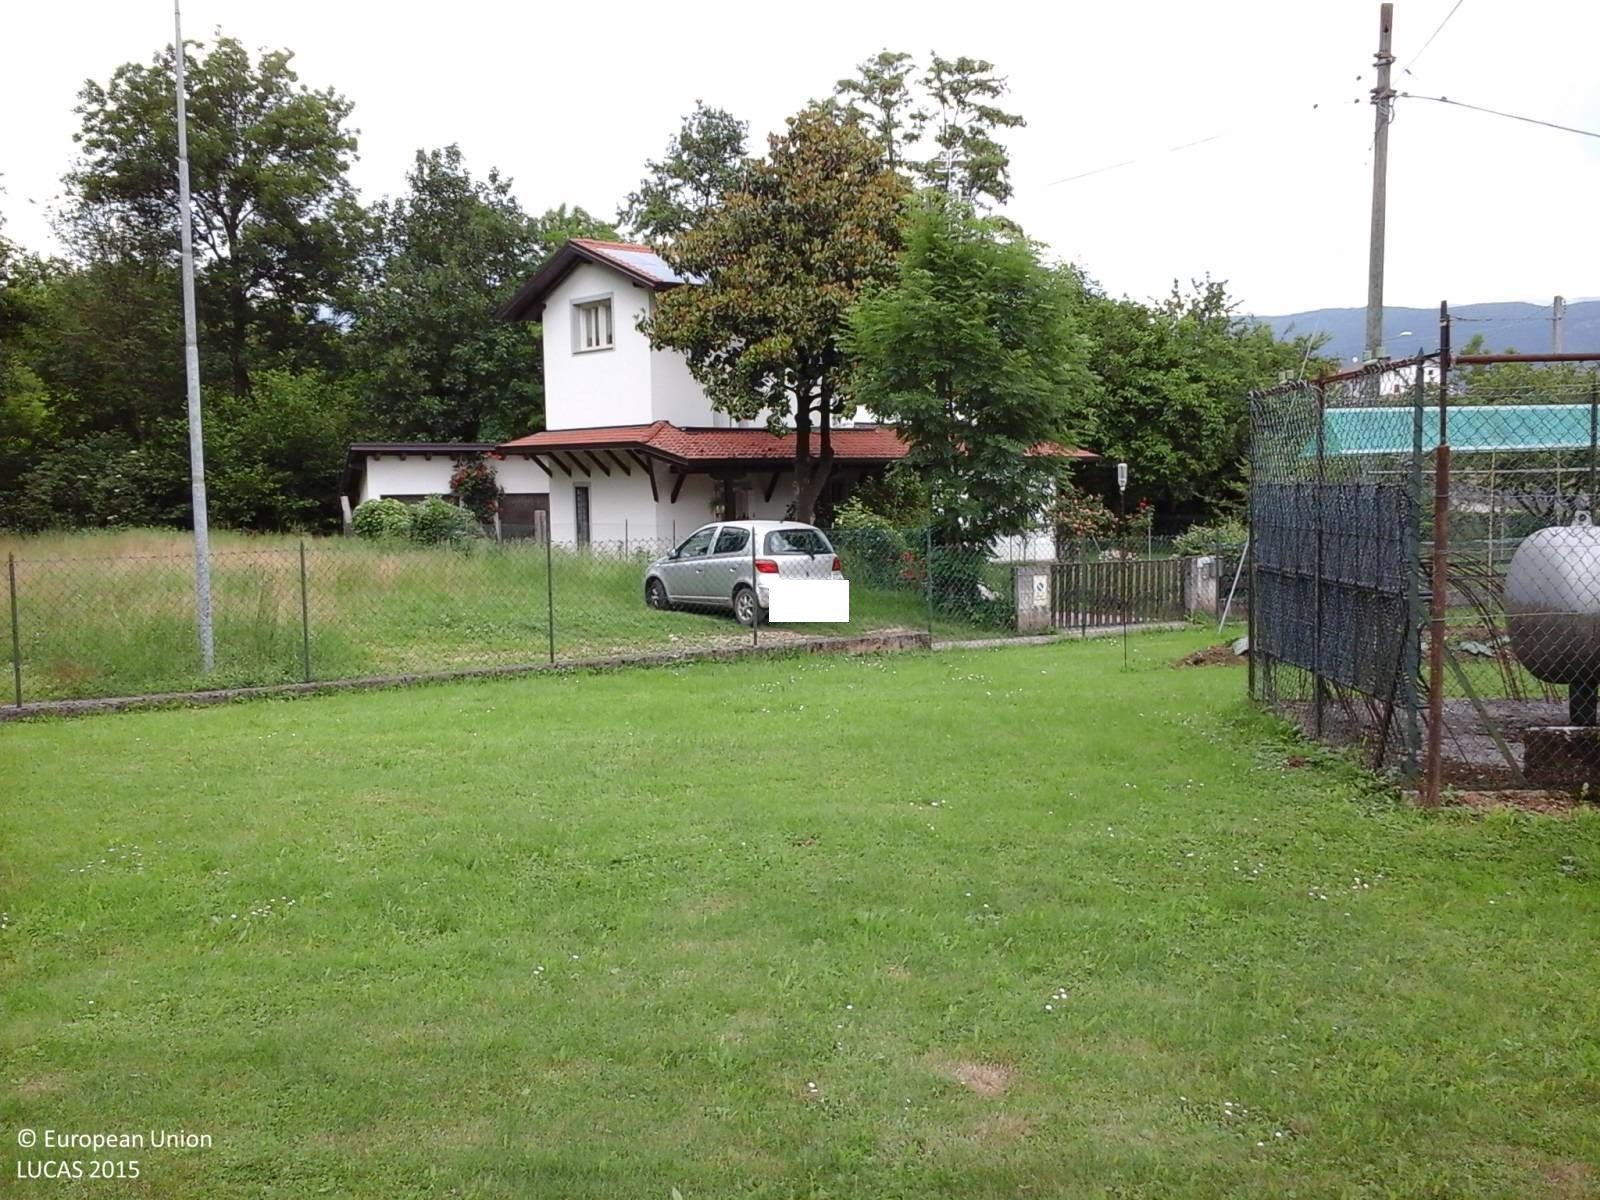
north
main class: Grassland
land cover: Grassland with sparse tree/shrub cover
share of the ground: > 75 %
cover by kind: herbaceous plants 90 %, broadleaved forest trees 5 %, shrubs 5 %
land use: Residential
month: May
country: IT
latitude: 46.1765
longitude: 13.2220
